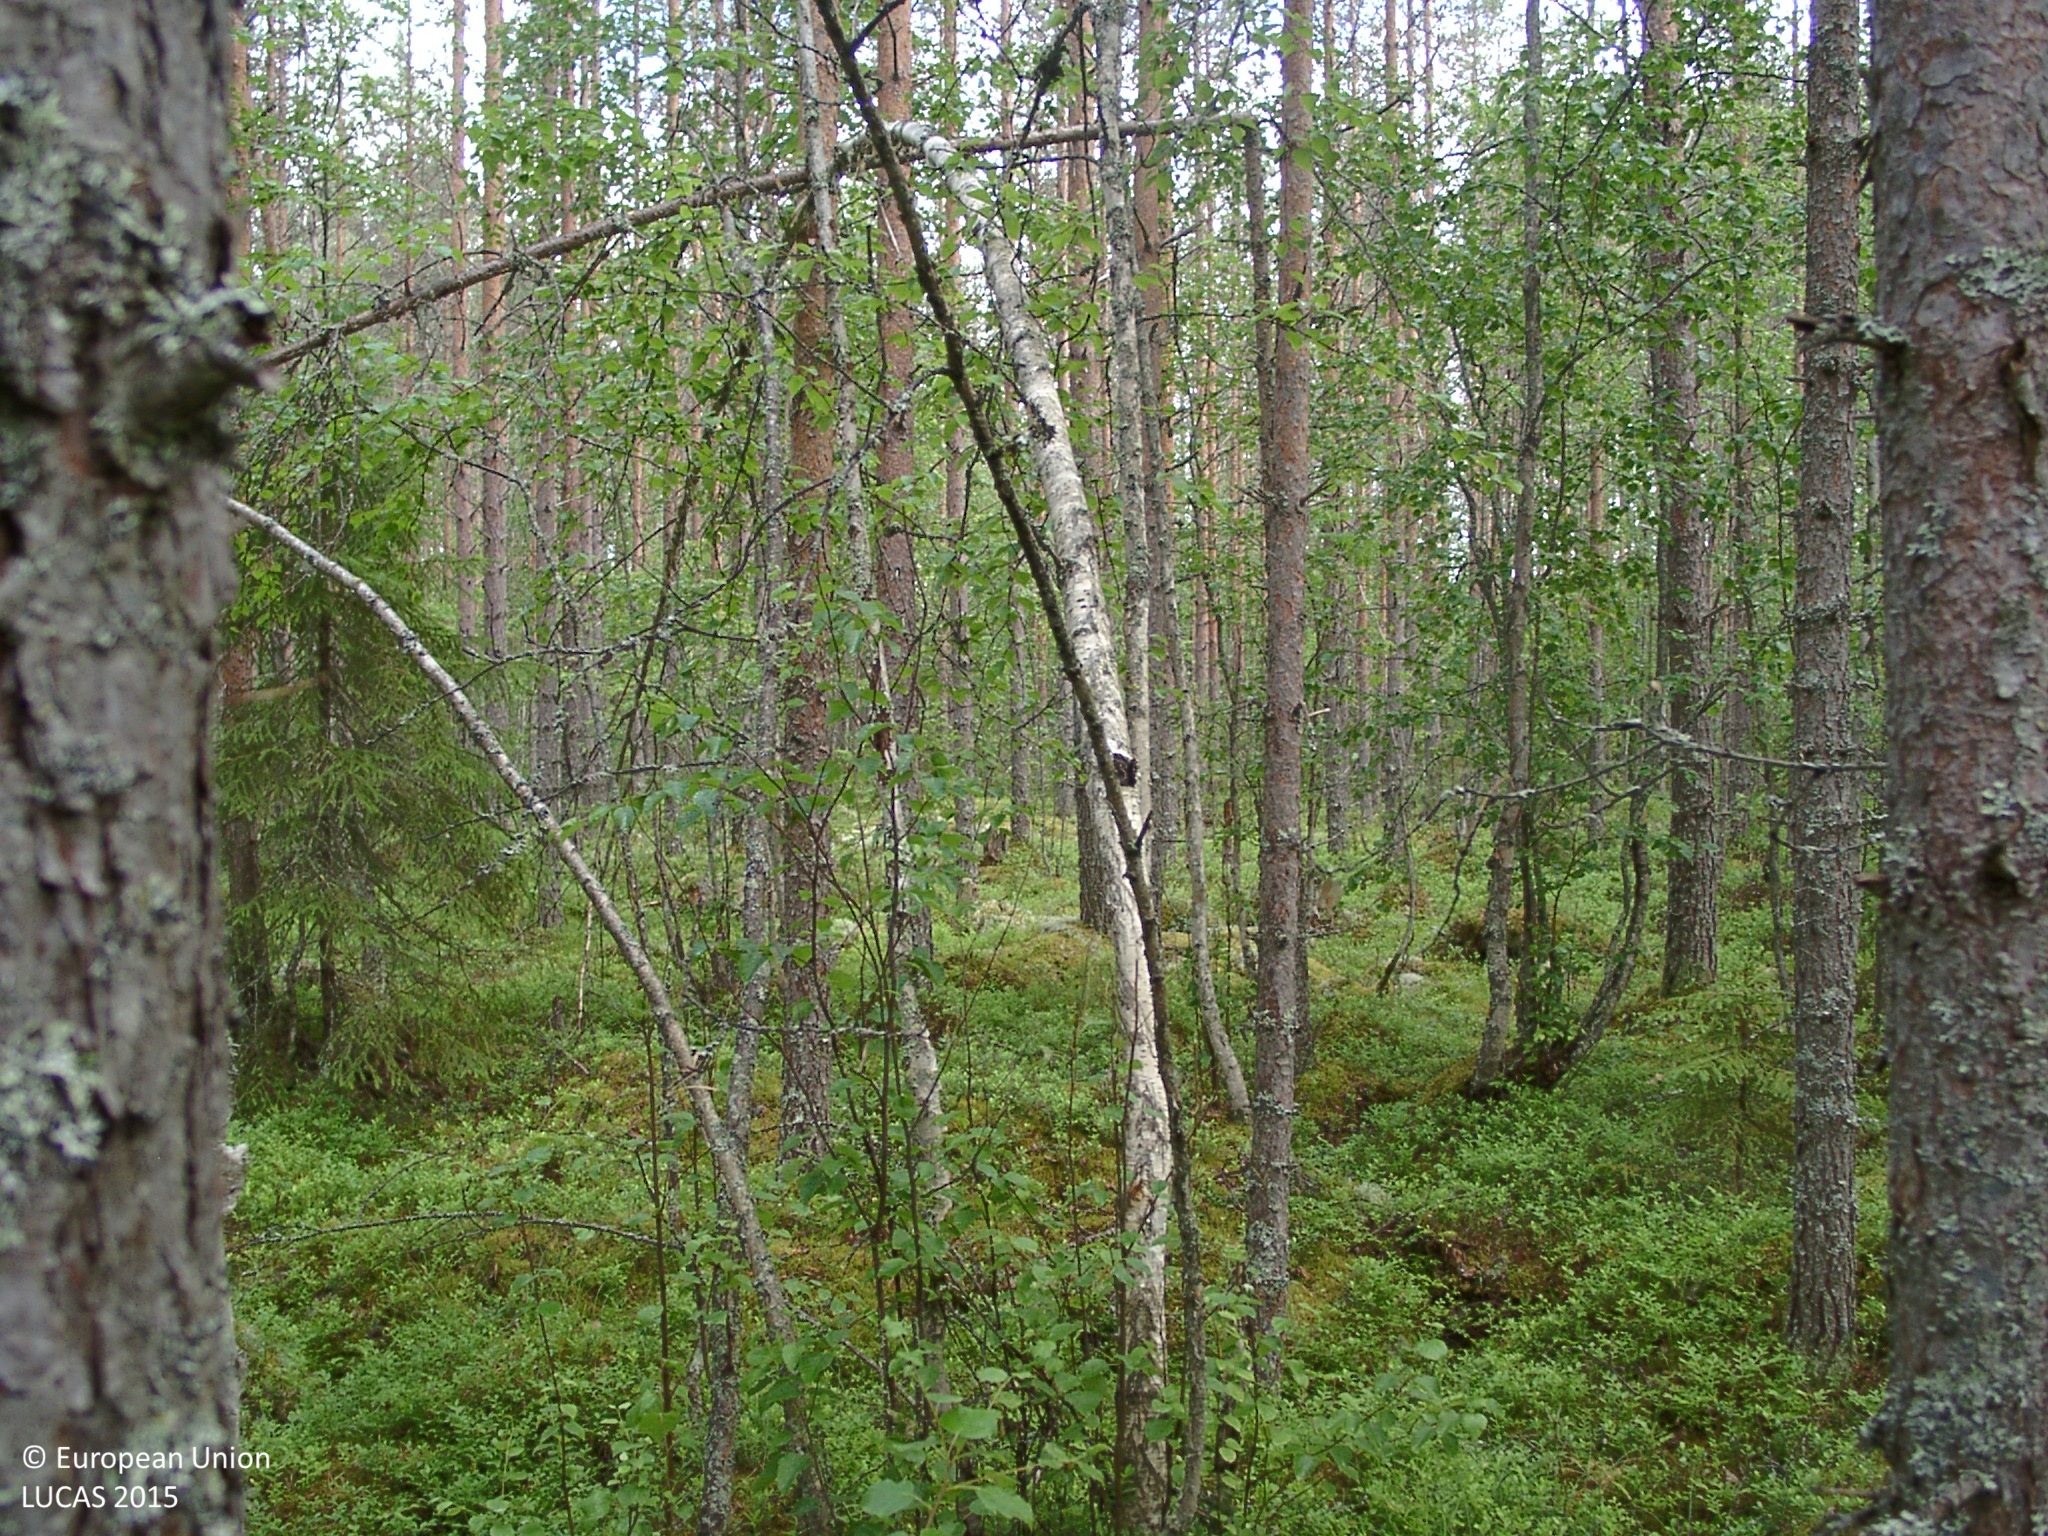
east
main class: Woodland
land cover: Other mixed woodland
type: boreal forest
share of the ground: 50 - 75 %
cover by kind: coniferous forest trees 55 %, broadleaved forest trees 20 %, shrubs 20 %, lichens and mosses 5 %
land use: Semi-natural and natural areas not in use
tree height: > 5 m
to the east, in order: Other mixed woodland; Other coniferous woodland; Pine dominated mixed woodland; Electric lines; Pine dominated mixed woodland; Electric lines; Pine dominated mixed woodland; Spruce dominated mixed woodland; Grass margins; Spruce dominated mixed woodland; Rivers and streams; Spruce dominated mixed woodland
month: July
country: FI
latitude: 62.1580
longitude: 25.0955
